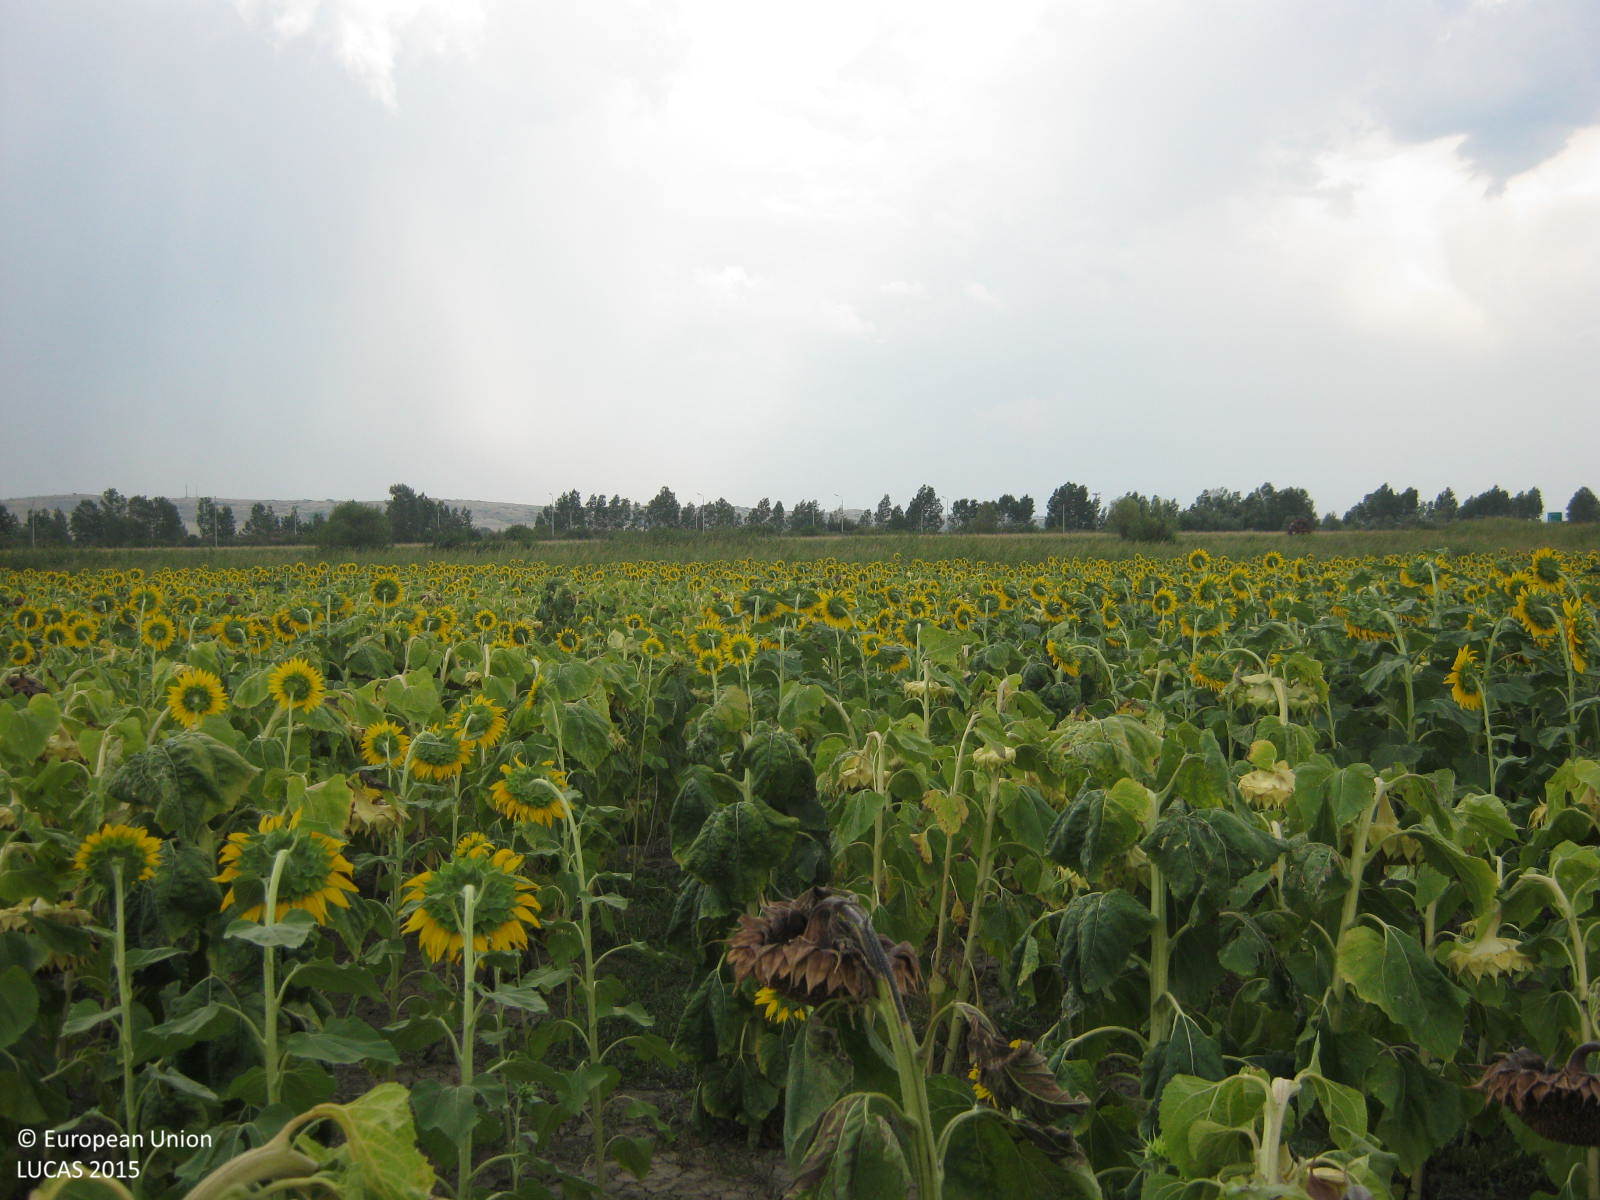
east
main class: Cropland
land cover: Sunflower
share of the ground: > 75 %
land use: Agriculture (excluding fallow land and kitchen gardens)
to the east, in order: Sunflower; Spontaneously vegetated surfaces; Inland marshes; Rivers and streams; Inland marshes; Maize
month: August
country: GR
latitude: 41.0056
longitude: 22.5984
